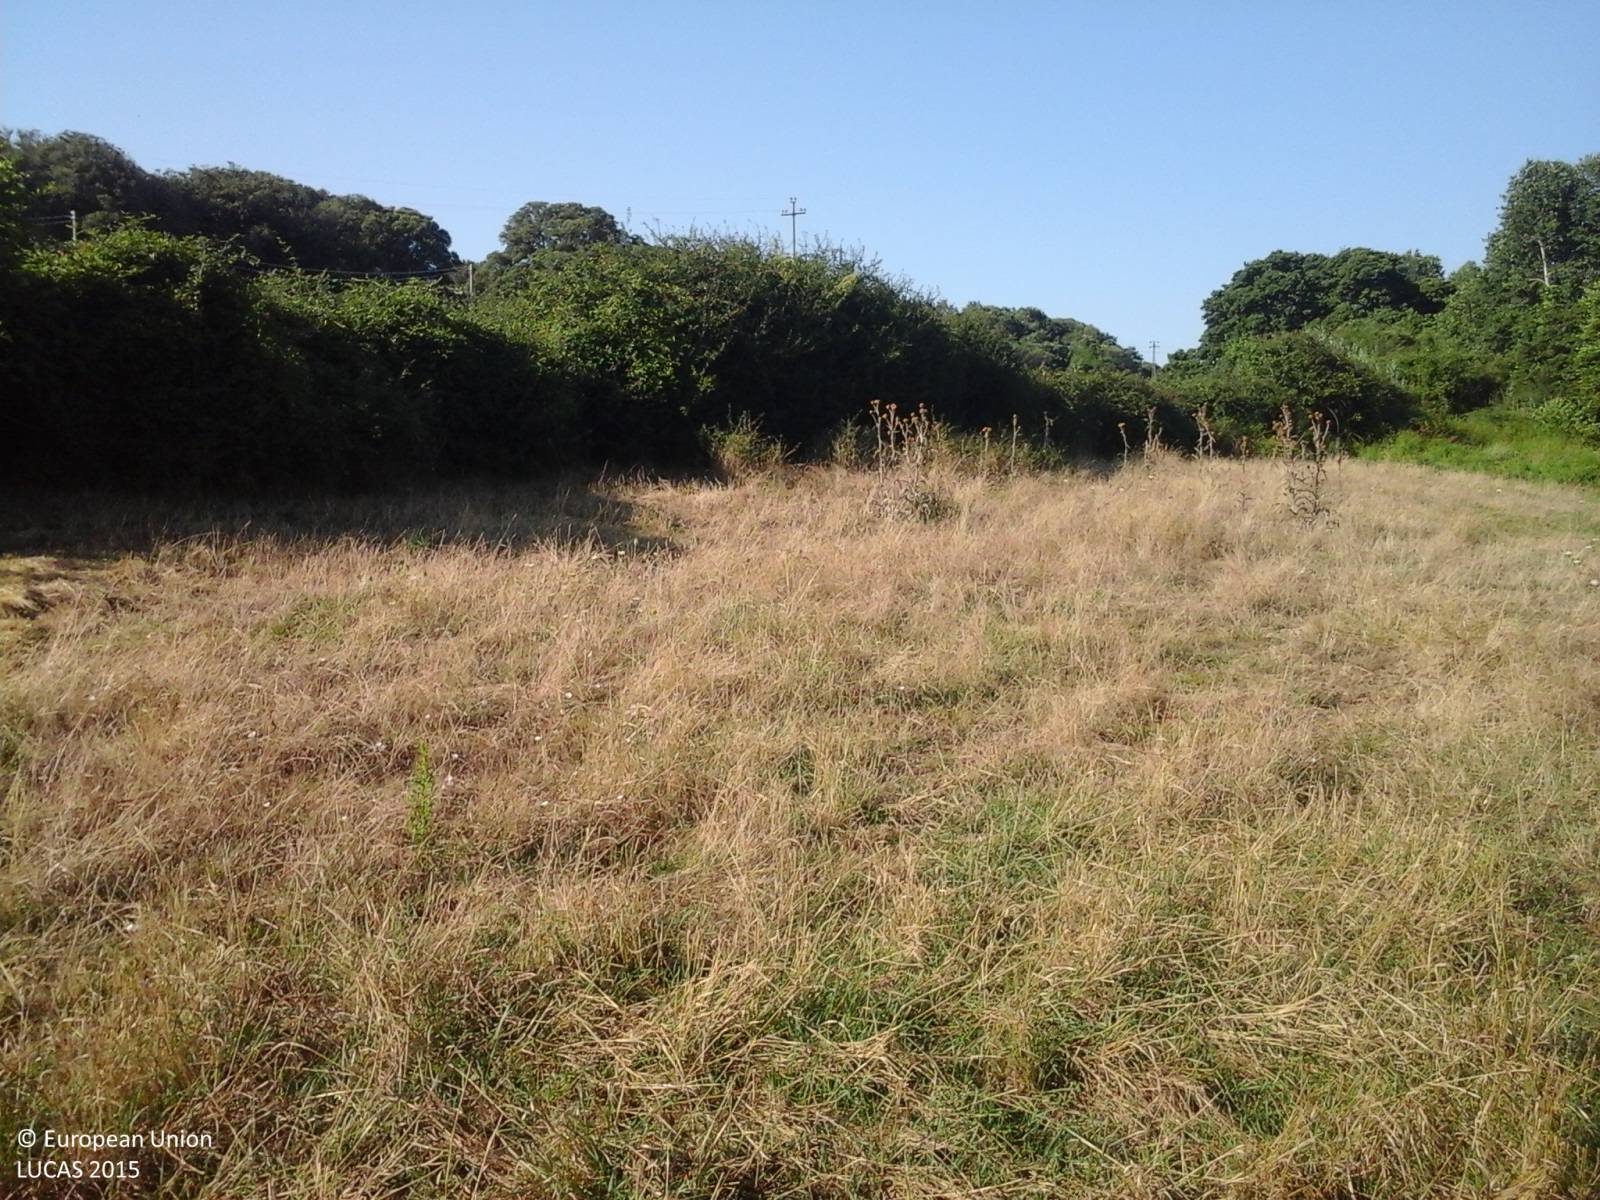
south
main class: Grassland
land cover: Grassland without tree/shrub cover
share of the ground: > 75 %
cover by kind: herbaceous plants 100 %
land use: Agriculture (excluding fallow land and kitchen gardens)
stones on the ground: < 10 %
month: August
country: IT
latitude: 40.9152
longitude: 9.1609
